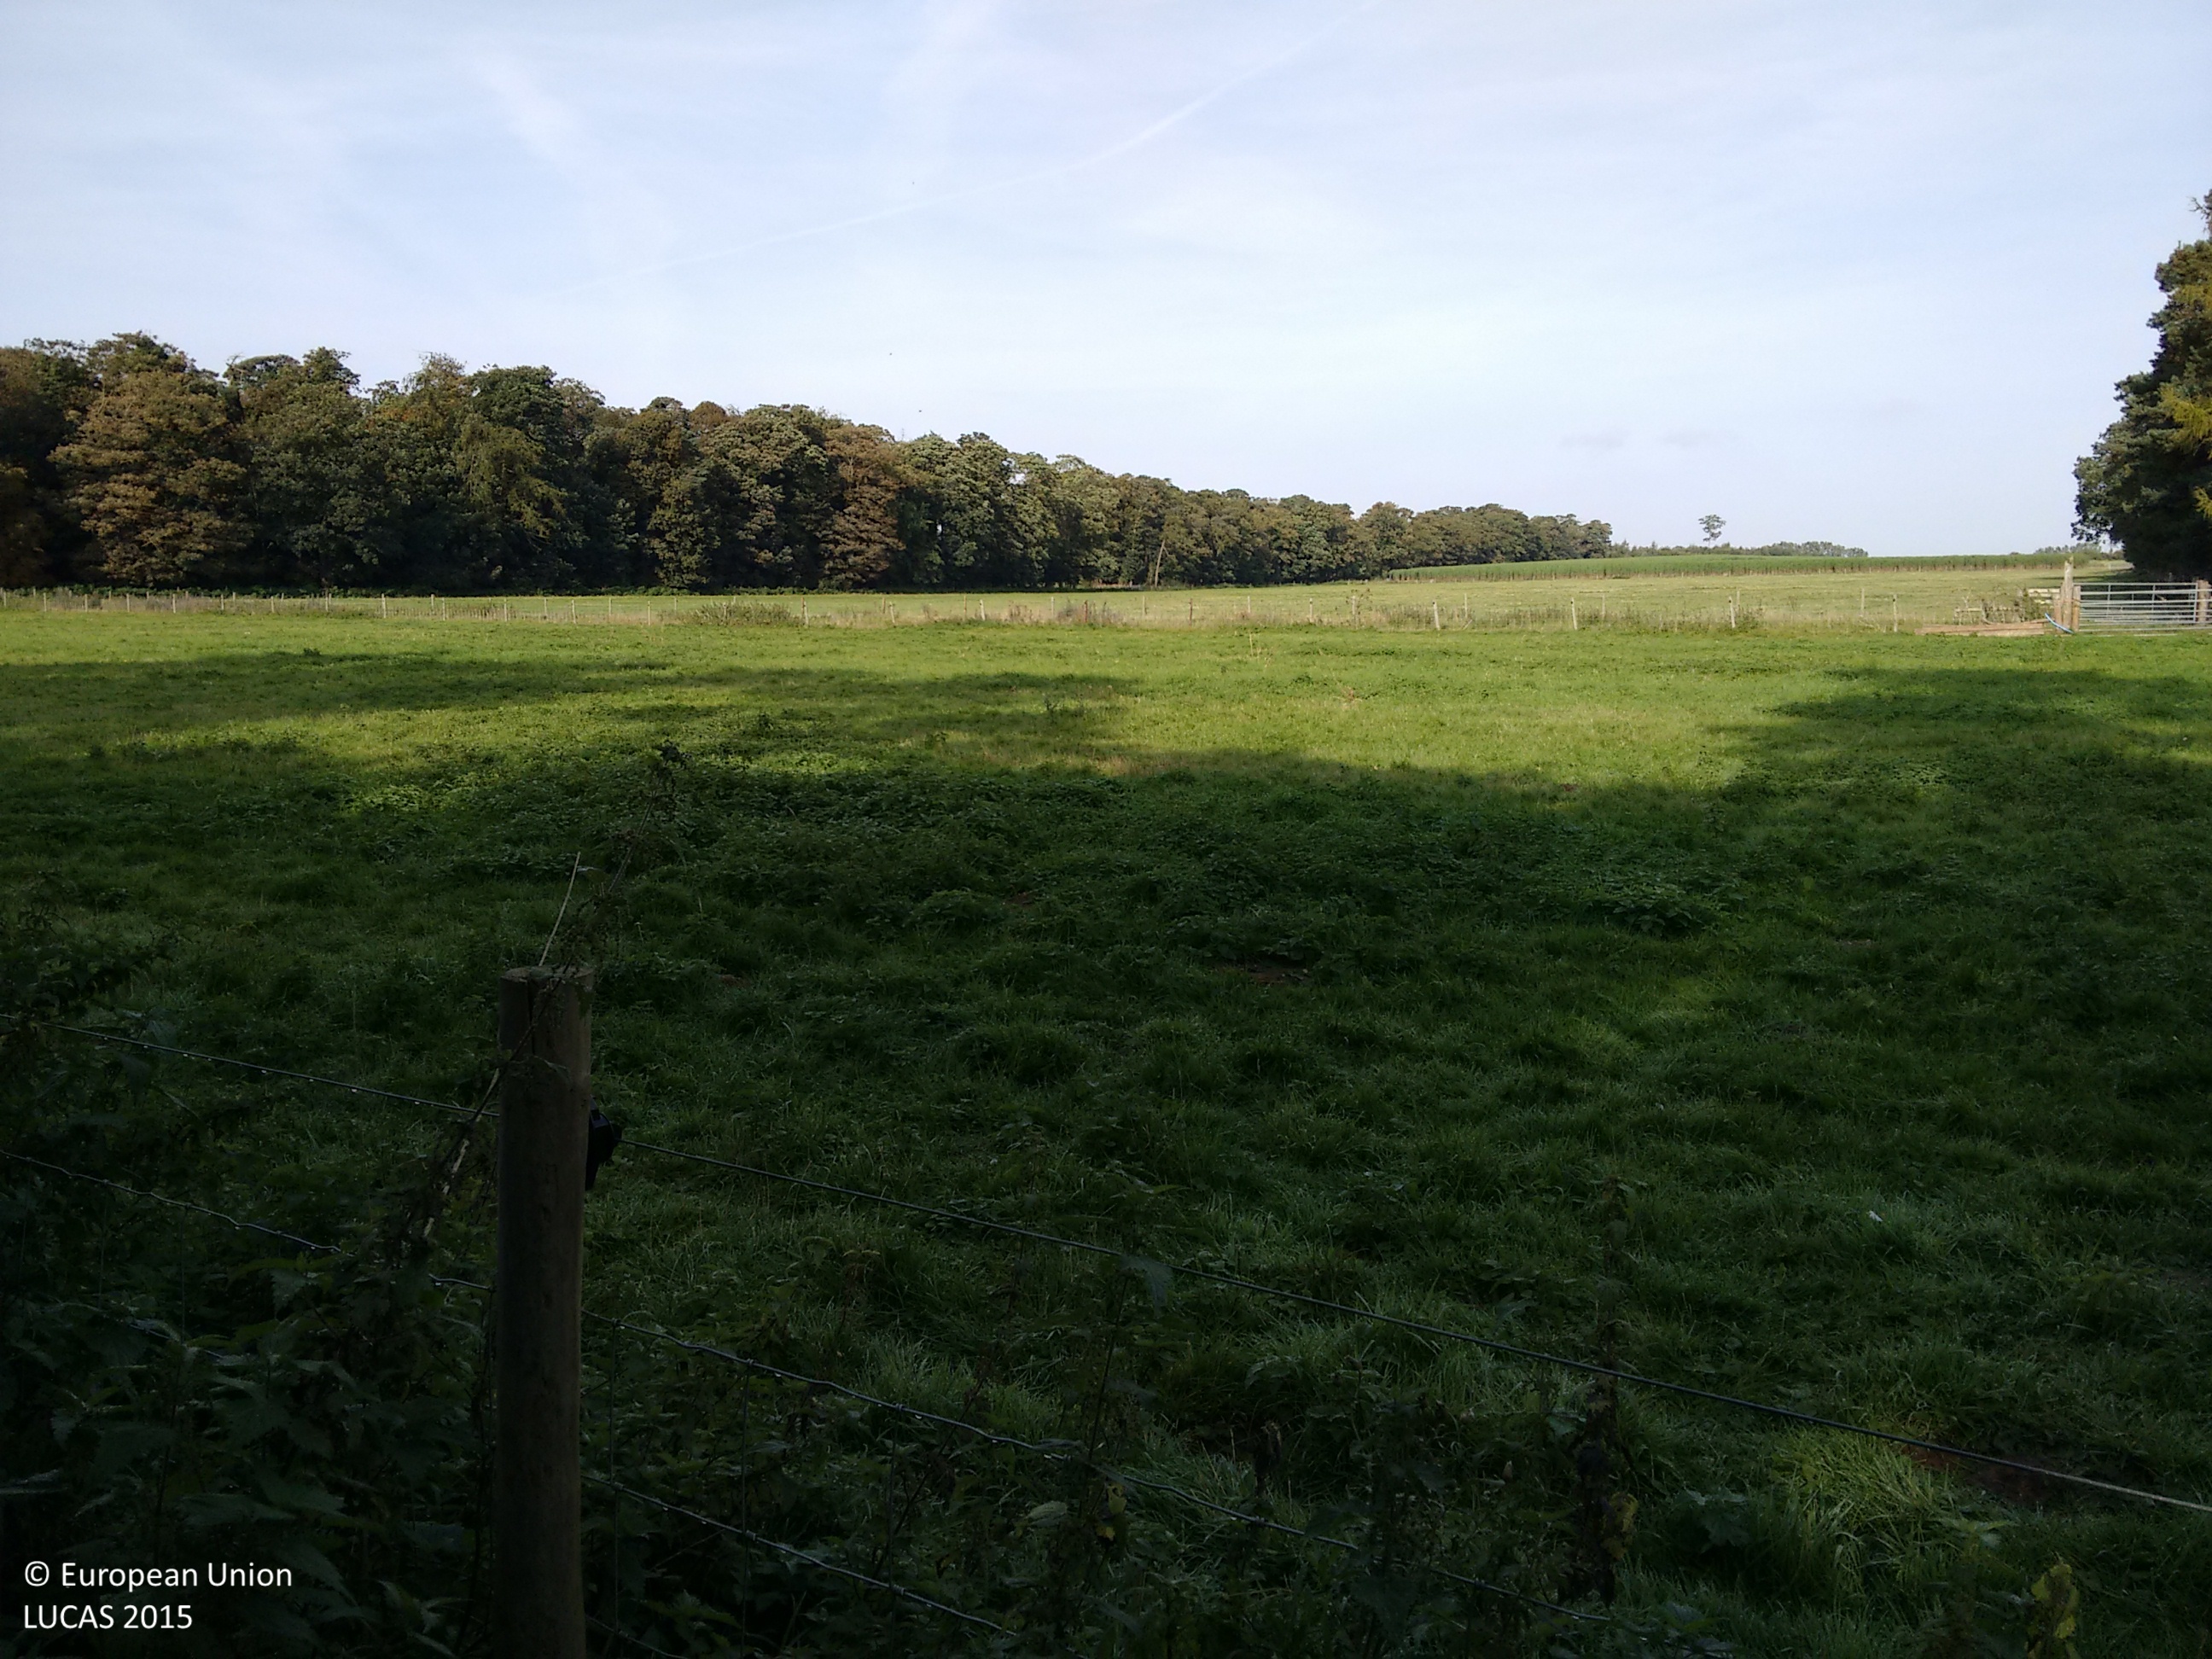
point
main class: Grassland
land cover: Grassland without tree/shrub cover
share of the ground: > 75 %
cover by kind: herbaceous plants 100 %
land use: Agriculture (excluding fallow land and kitchen gardens)
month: September
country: GB
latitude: 52.4211
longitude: 0.8441
